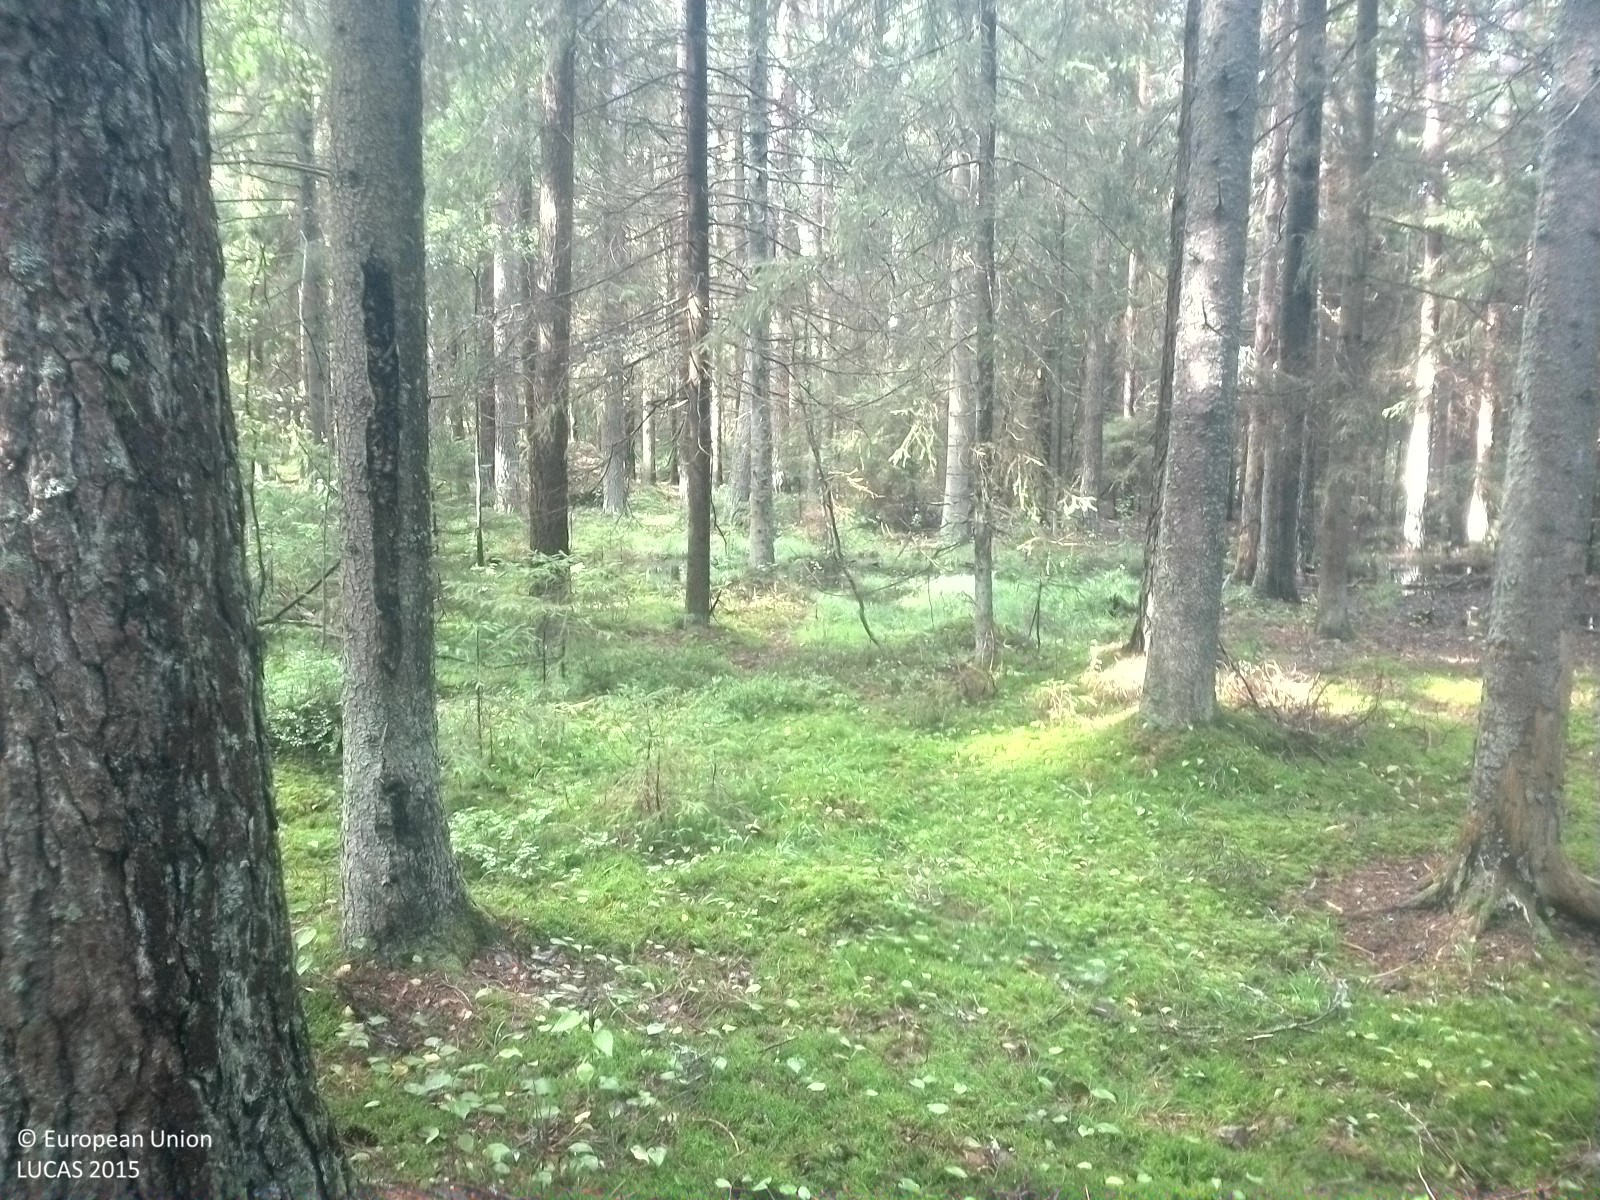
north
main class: Woodland
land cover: Other coniferous woodland
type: boreal forest
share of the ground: 25 - 50 %
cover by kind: lichens and mosses 45 %, coniferous forest trees 40 %, herbaceous plants 15 %
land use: Forestry
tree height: > 5 m
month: August
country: SE
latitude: 59.1346
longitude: 15.0425
